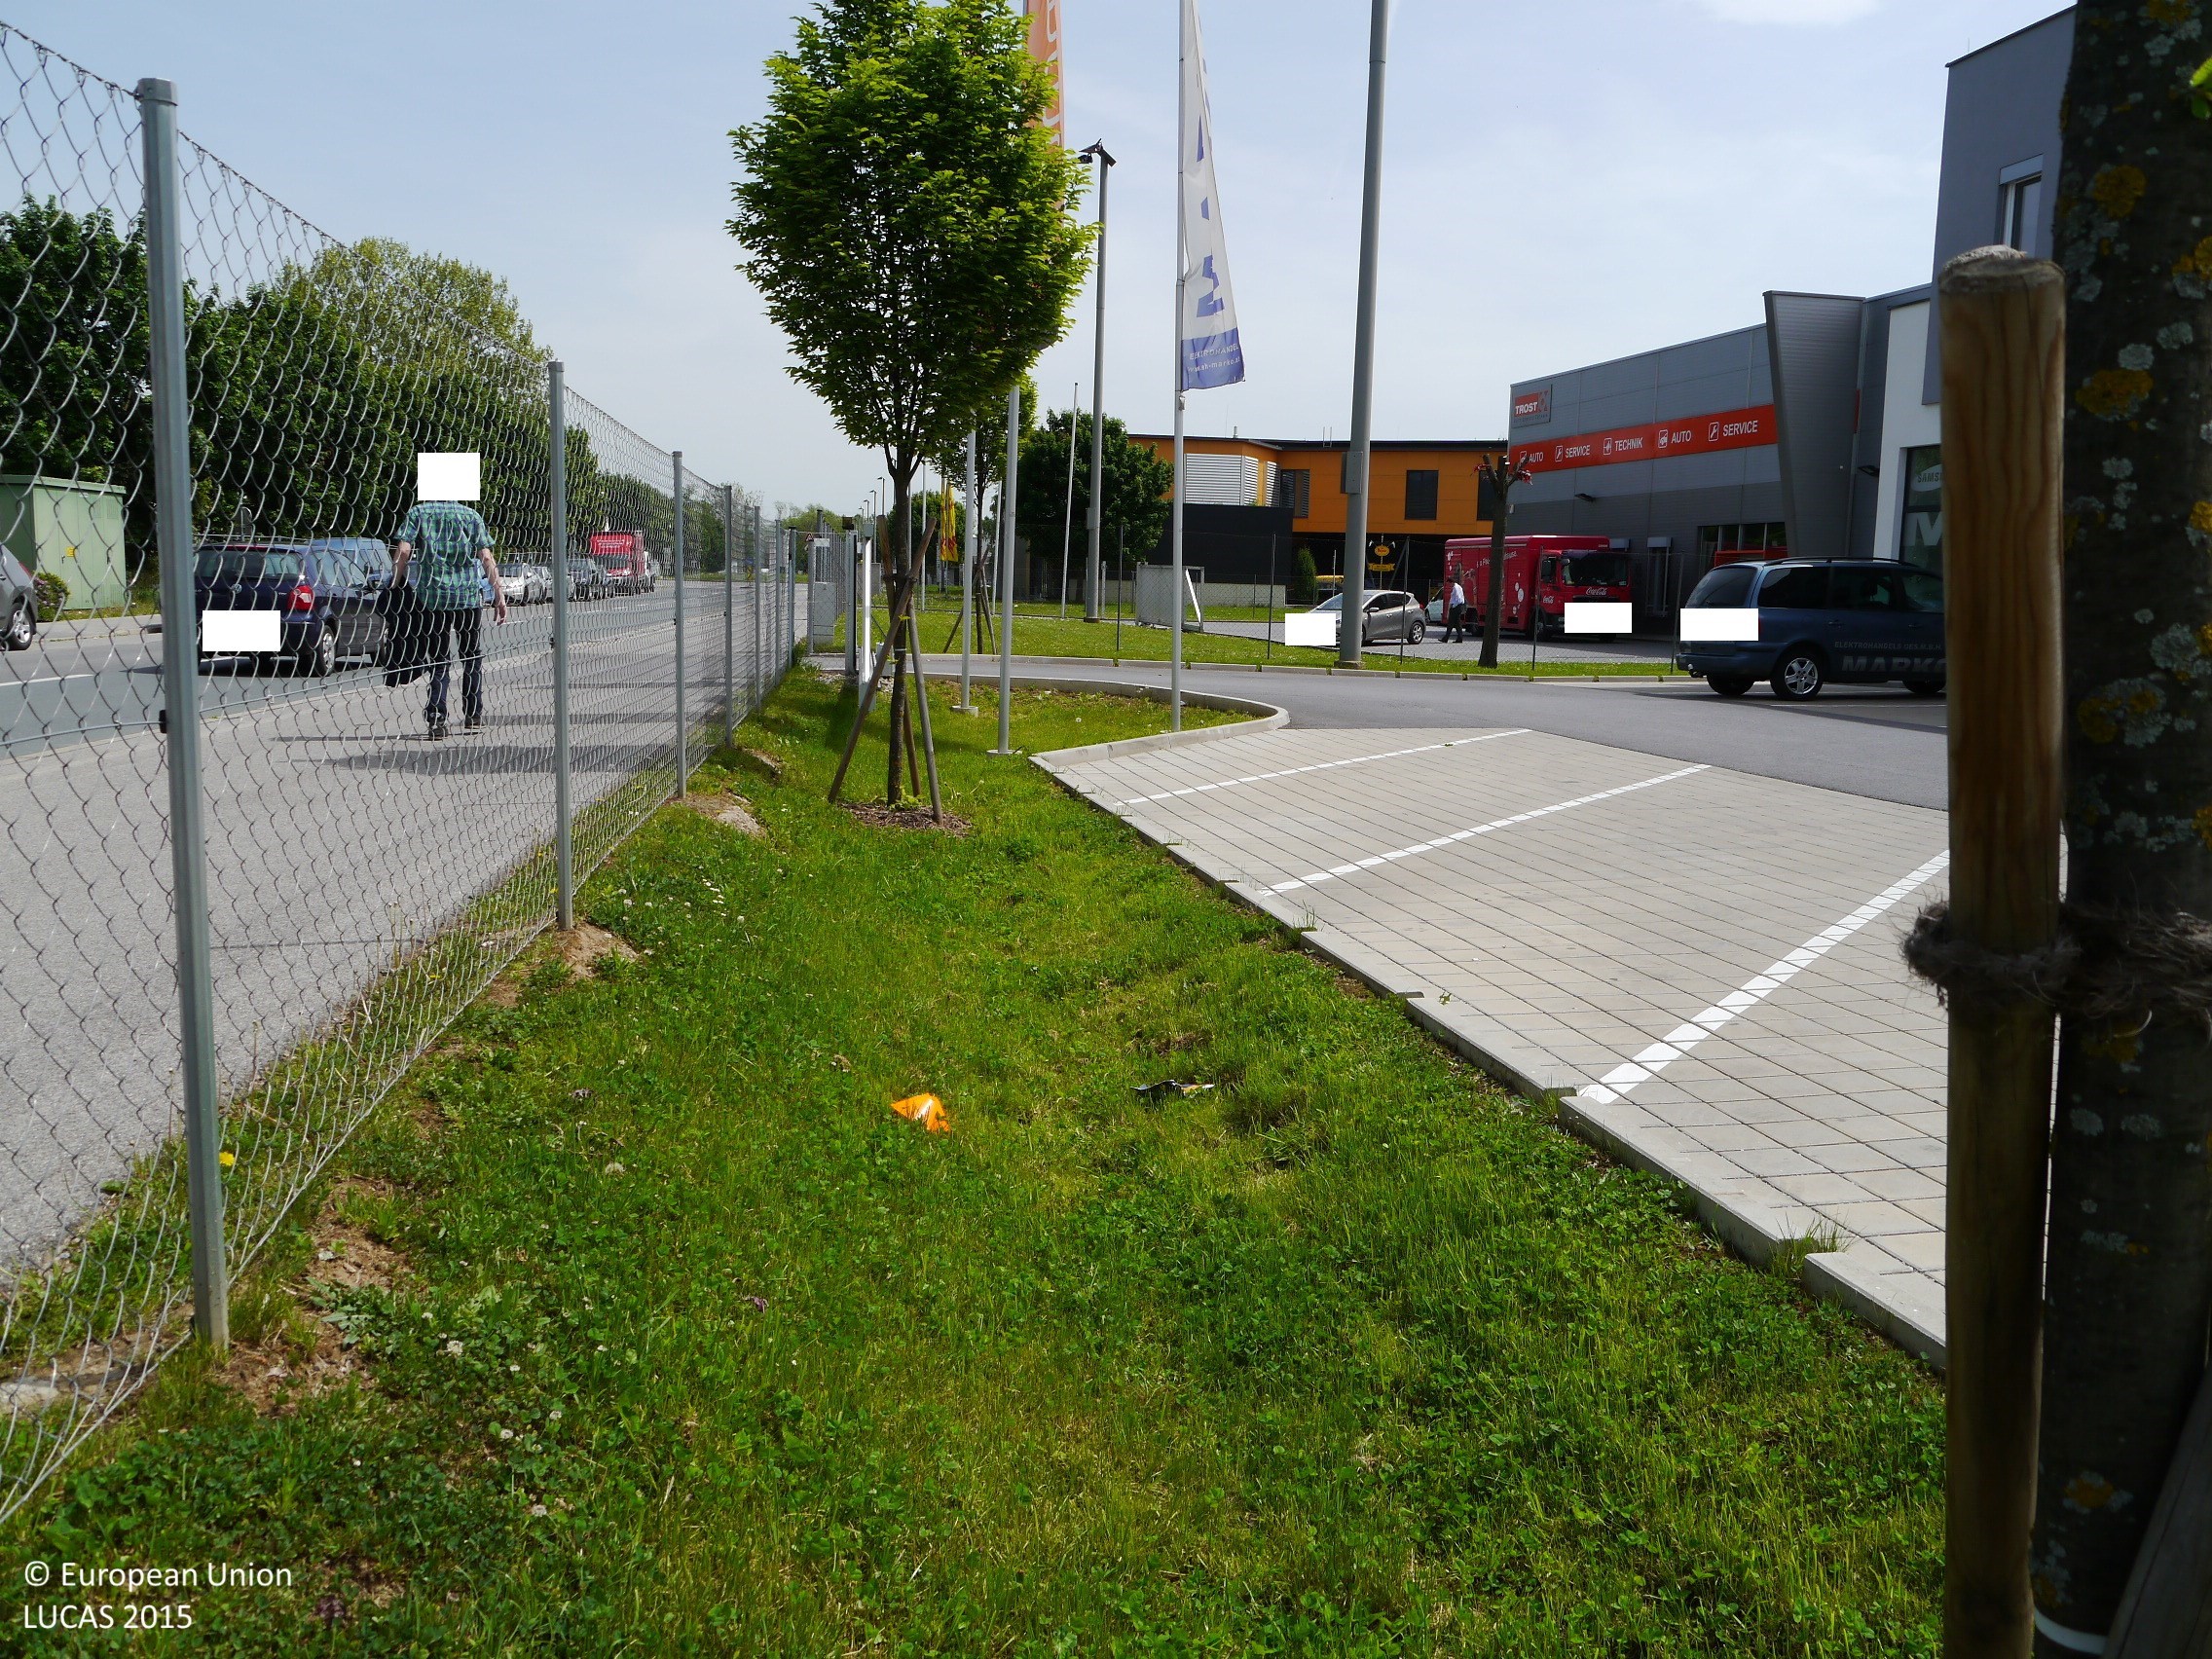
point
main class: Grassland
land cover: Grassland with sparse tree/shrub cover
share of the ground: > 75 %
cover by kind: herbaceous plants 95 %, broadleaved forest trees 5 %
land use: Commerce
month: May
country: AT
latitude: 47.0432
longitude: 15.4356
